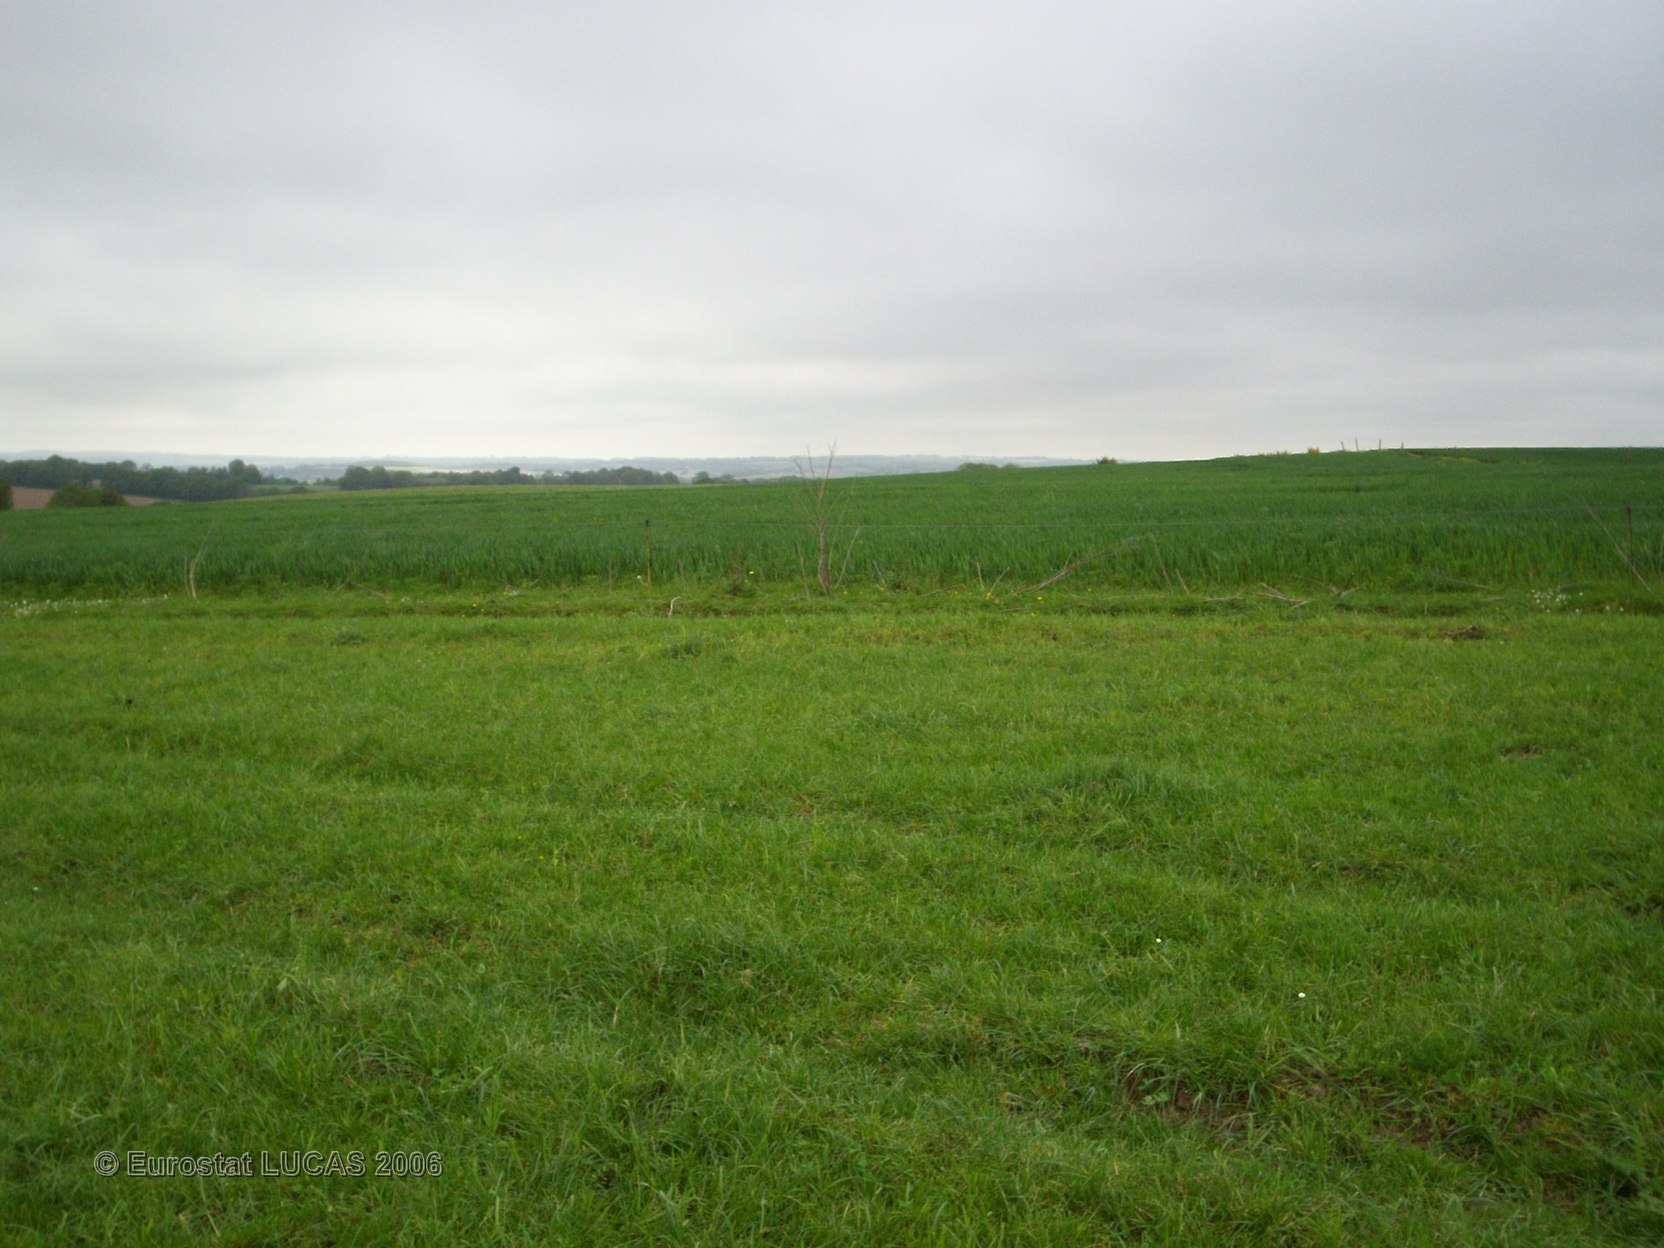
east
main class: Grassland
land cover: Grassland without tree/shrub cover
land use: Agriculture (excluding fallow land and kitchen gardens)
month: May
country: FR
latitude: 48.2275
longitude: -2.8961
